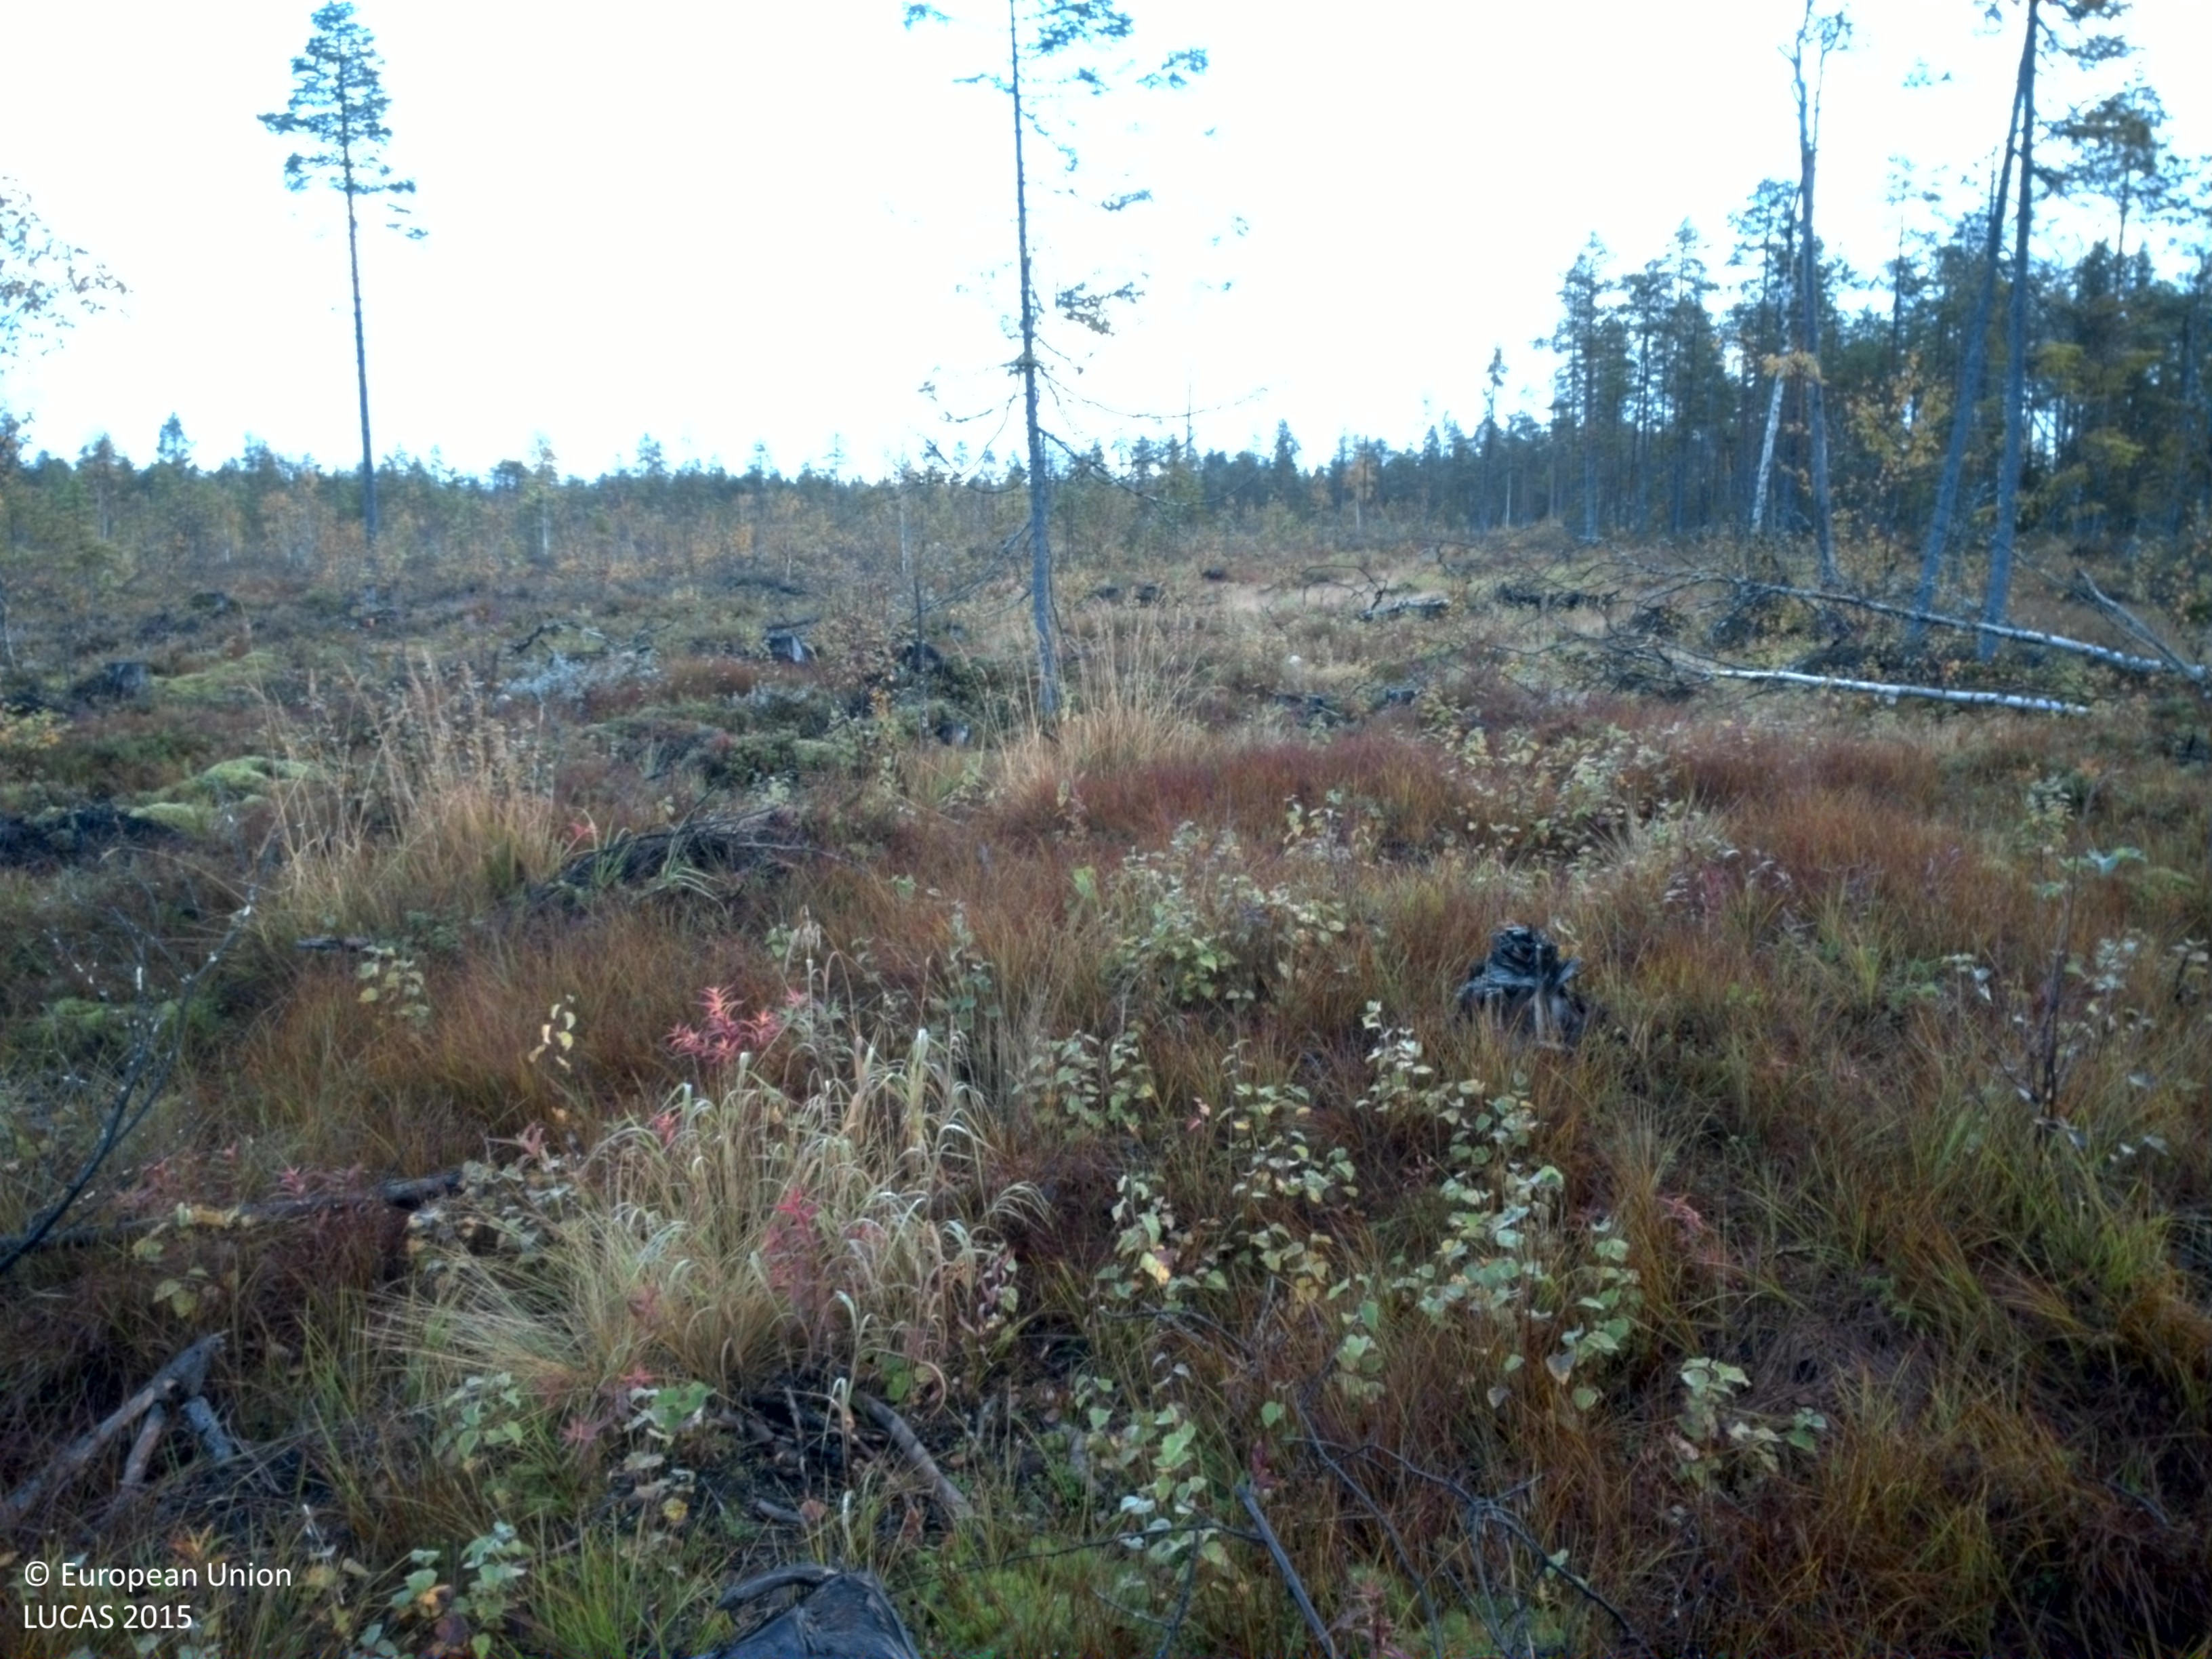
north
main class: Shrubland
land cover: Shrubland with sparse tree cover
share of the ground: 25 - 50 %
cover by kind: herbaceous plants 45 %, shrubs 40 %, lichens and mosses 10 %, broadleaved forest trees 5 %
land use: Forestry
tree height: < 5 m
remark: Clear cut
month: September
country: SE
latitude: 65.5807
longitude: 21.8782
